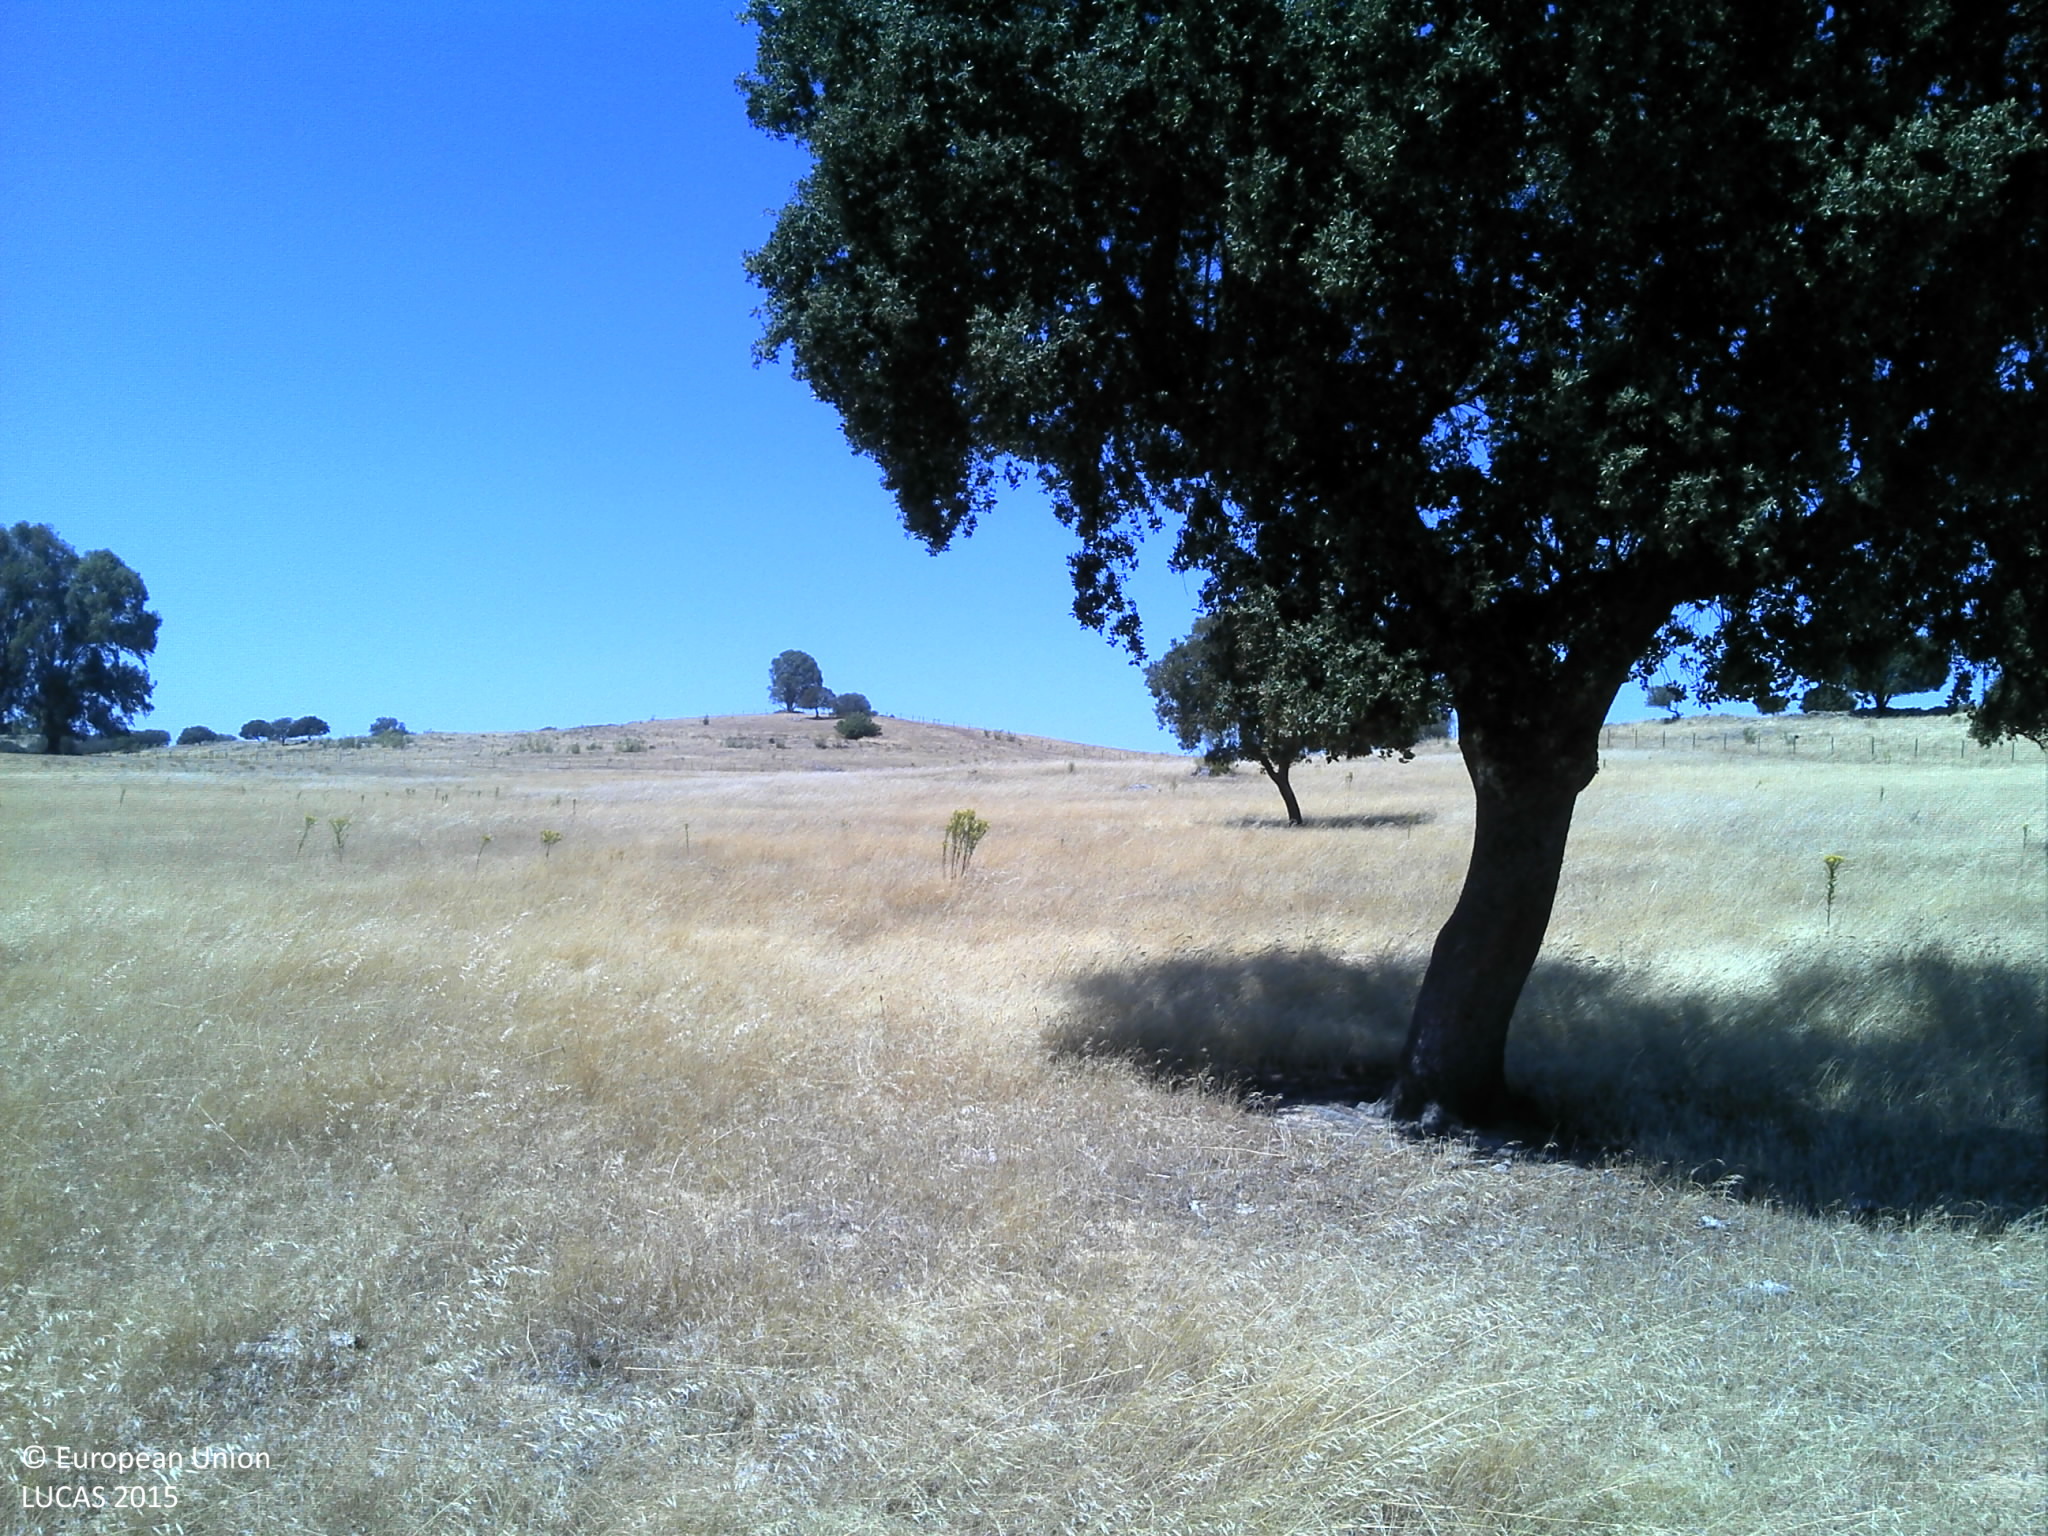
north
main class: Grassland
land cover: Grassland with sparse tree/shrub cover
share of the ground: > 75 %
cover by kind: herbaceous plants 75 %, unconsolidated bare surface 20 %, broadleaved forest trees 5 %
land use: Agriculture (excluding fallow land and kitchen gardens)
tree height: > 5 m
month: July
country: PT
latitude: 39.0947
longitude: -7.5575
